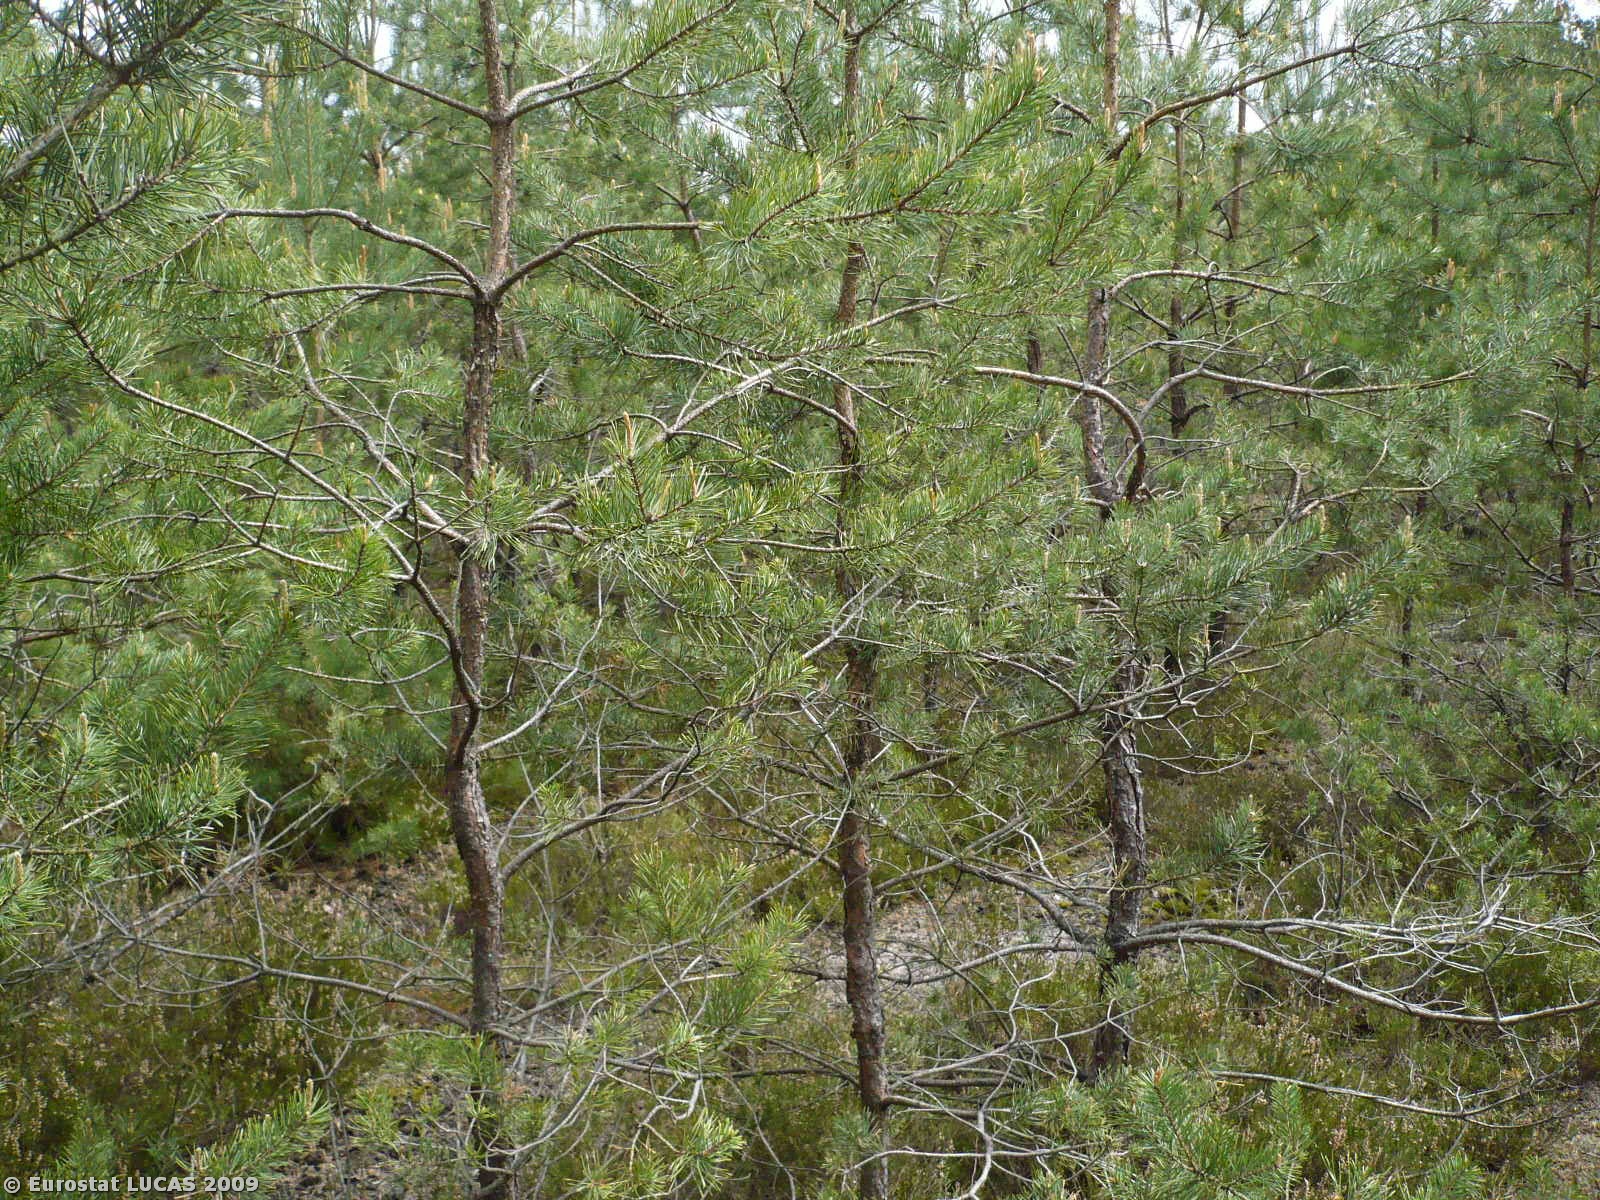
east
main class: Woodland
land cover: Coniferous woodland
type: hemiboreal forest and nemoral coniferous forest and mixed broadleaved-coniferous forest
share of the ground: 50 - 75 %
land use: Forestry
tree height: > 5 m
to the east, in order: Coniferous woodland; Tracks; Coniferous woodland; Tracks; Coniferous woodland
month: May
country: PL
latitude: 51.8704
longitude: 15.1300
